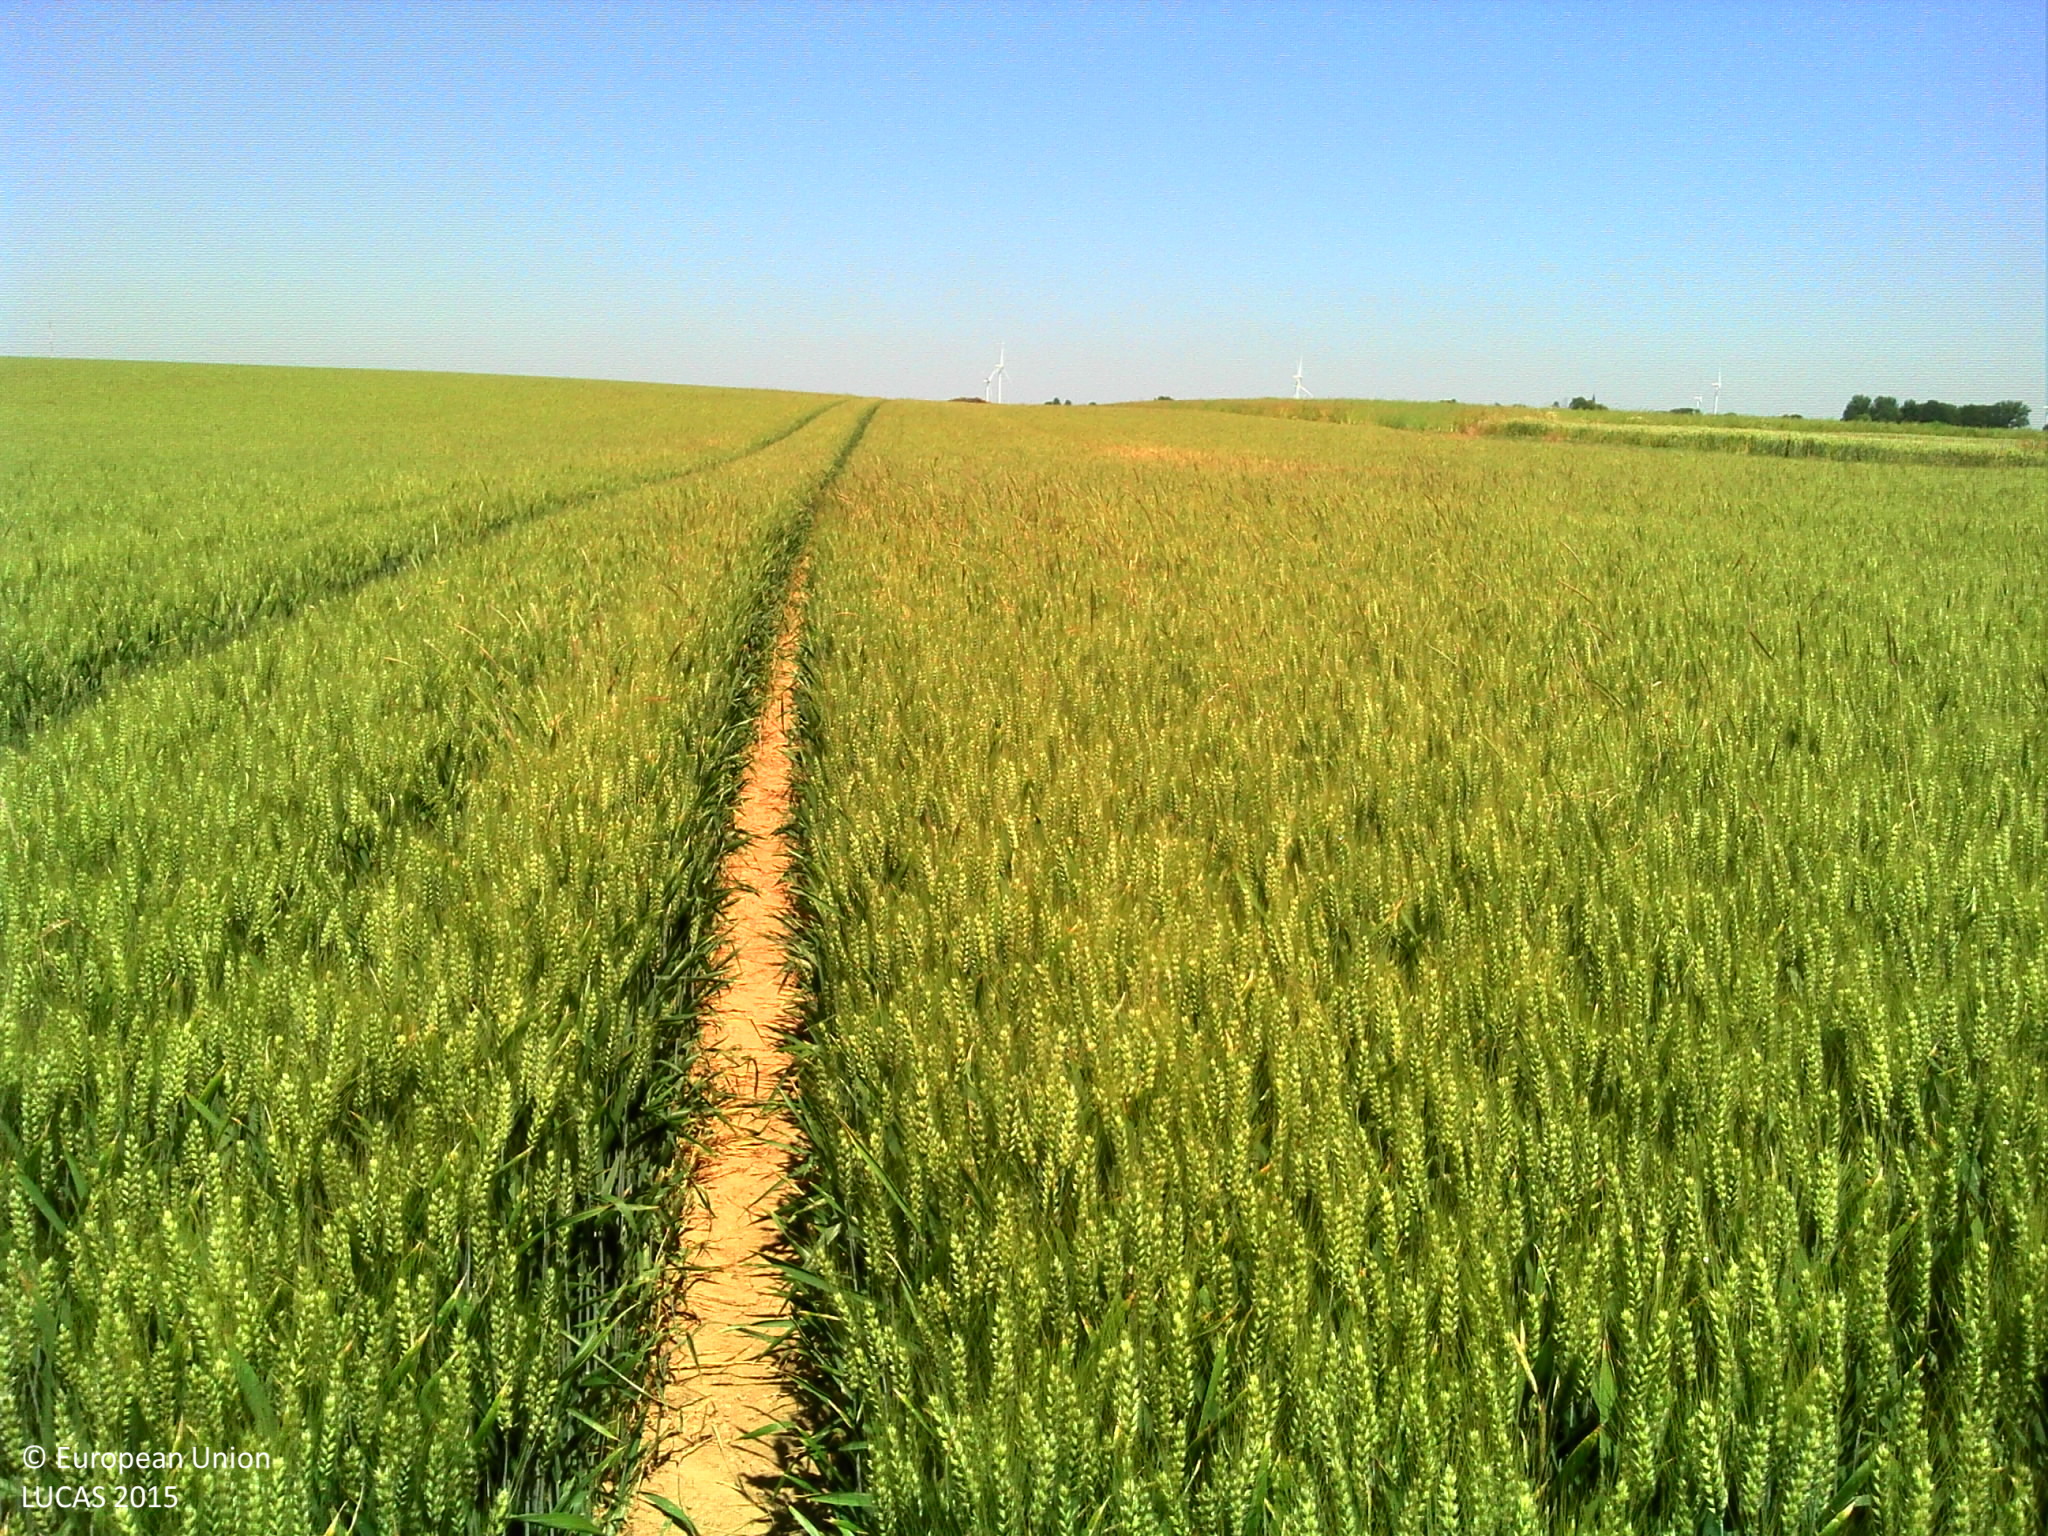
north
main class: Cropland
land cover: Common wheat
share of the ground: > 75 %
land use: Agriculture (excluding fallow land and kitchen gardens)
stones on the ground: < 10 %
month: June
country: FR
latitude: 50.3146
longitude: 2.4741
